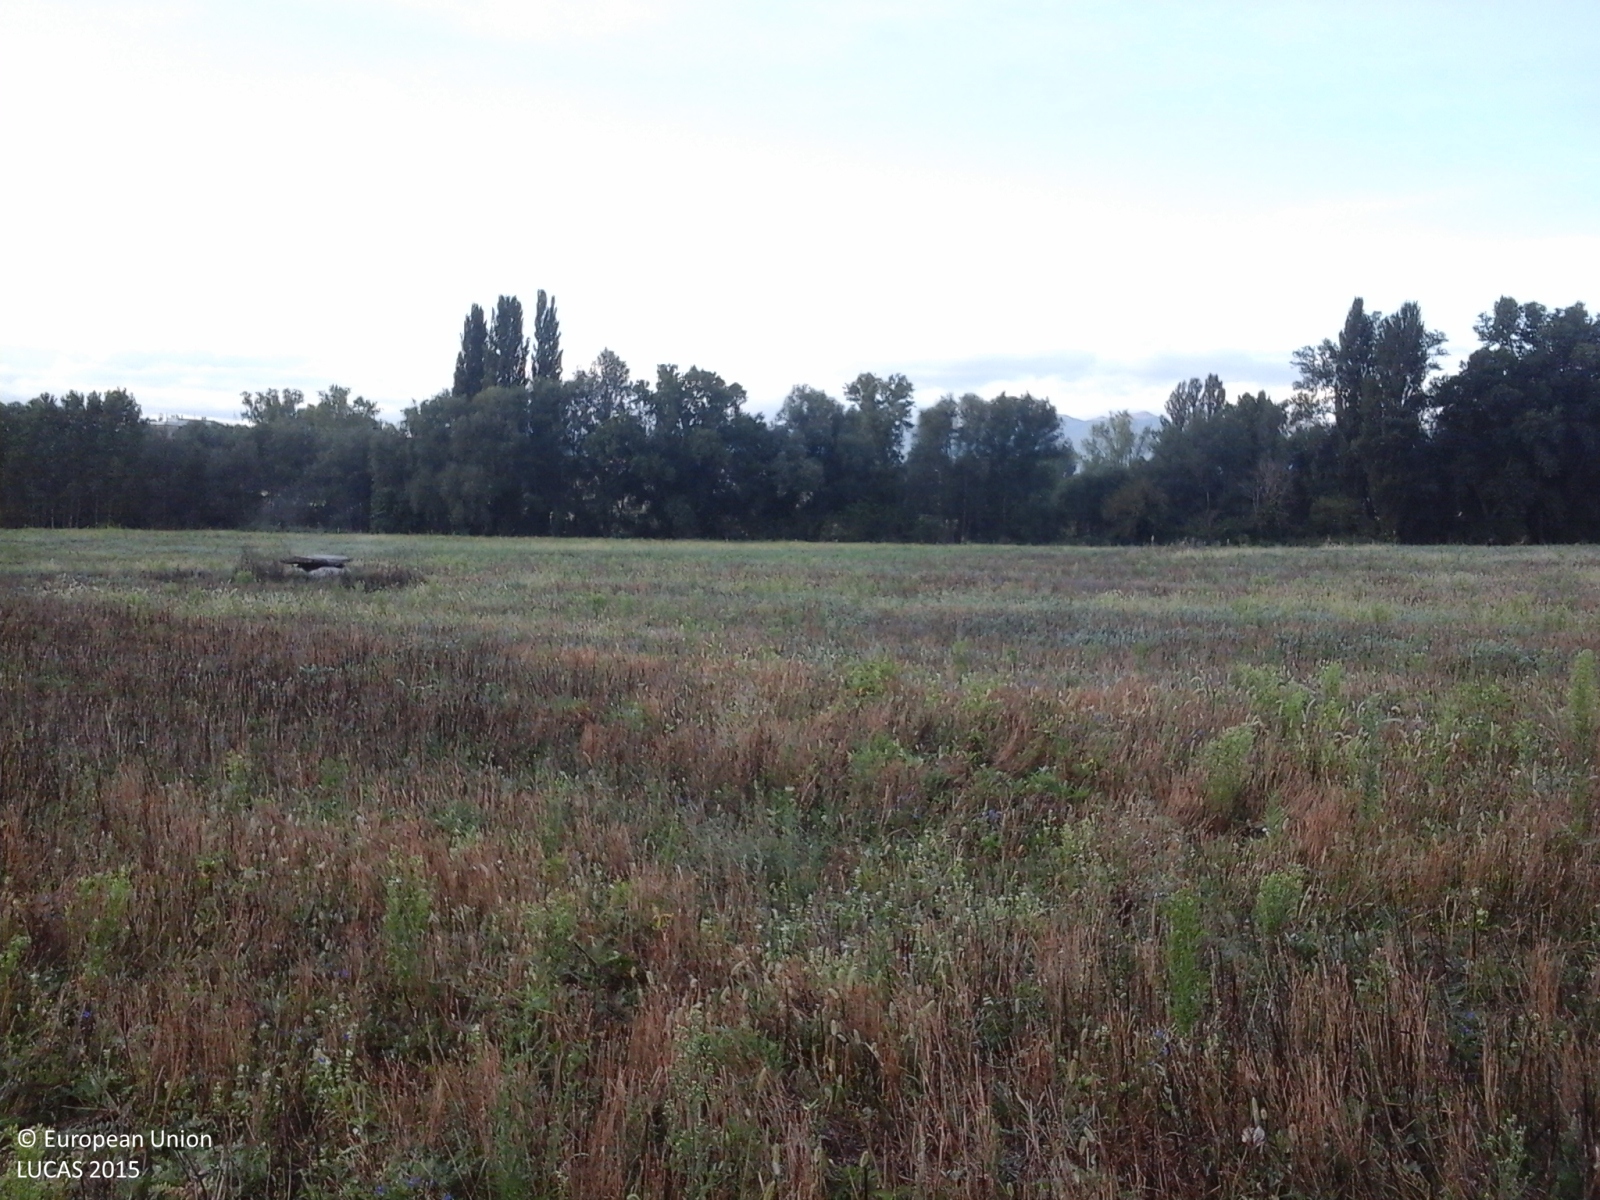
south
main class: Cropland
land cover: Barley
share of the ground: < 10 %
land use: Agriculture (excluding fallow land and kitchen gardens)
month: September
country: IT
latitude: 43.3326
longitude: 12.9891
